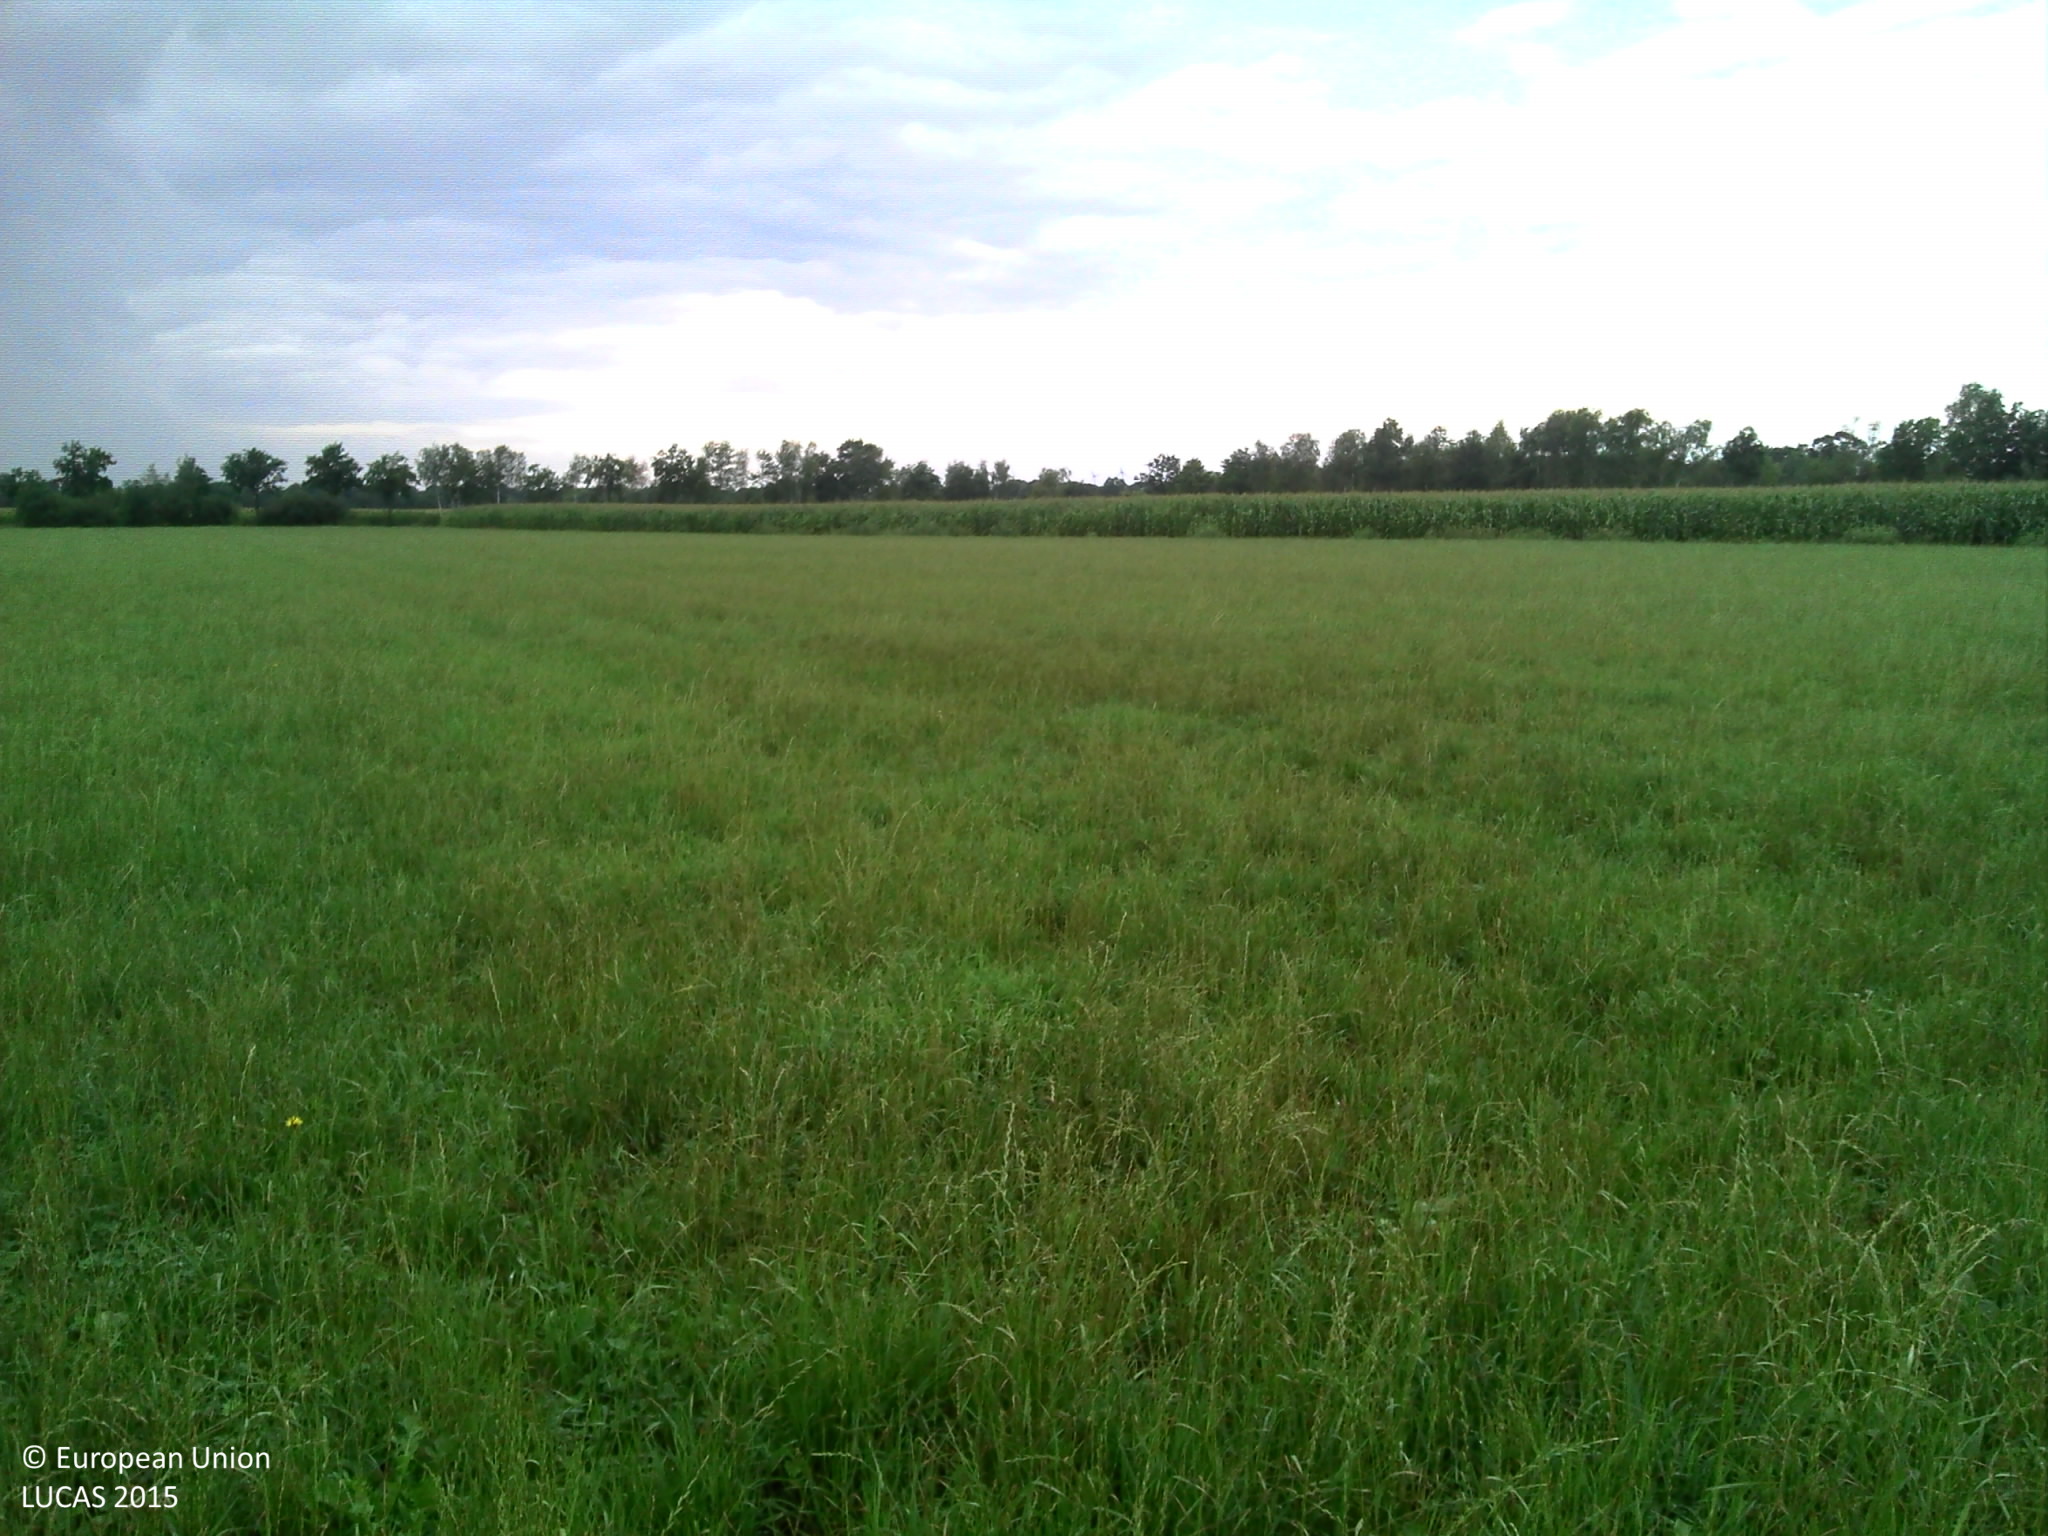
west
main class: Grassland
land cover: Grassland without tree/shrub cover
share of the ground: > 75 %
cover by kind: herbaceous plants 100 %
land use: Agriculture (excluding fallow land and kitchen gardens)
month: August
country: BE
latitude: 51.2874
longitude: 5.1366
